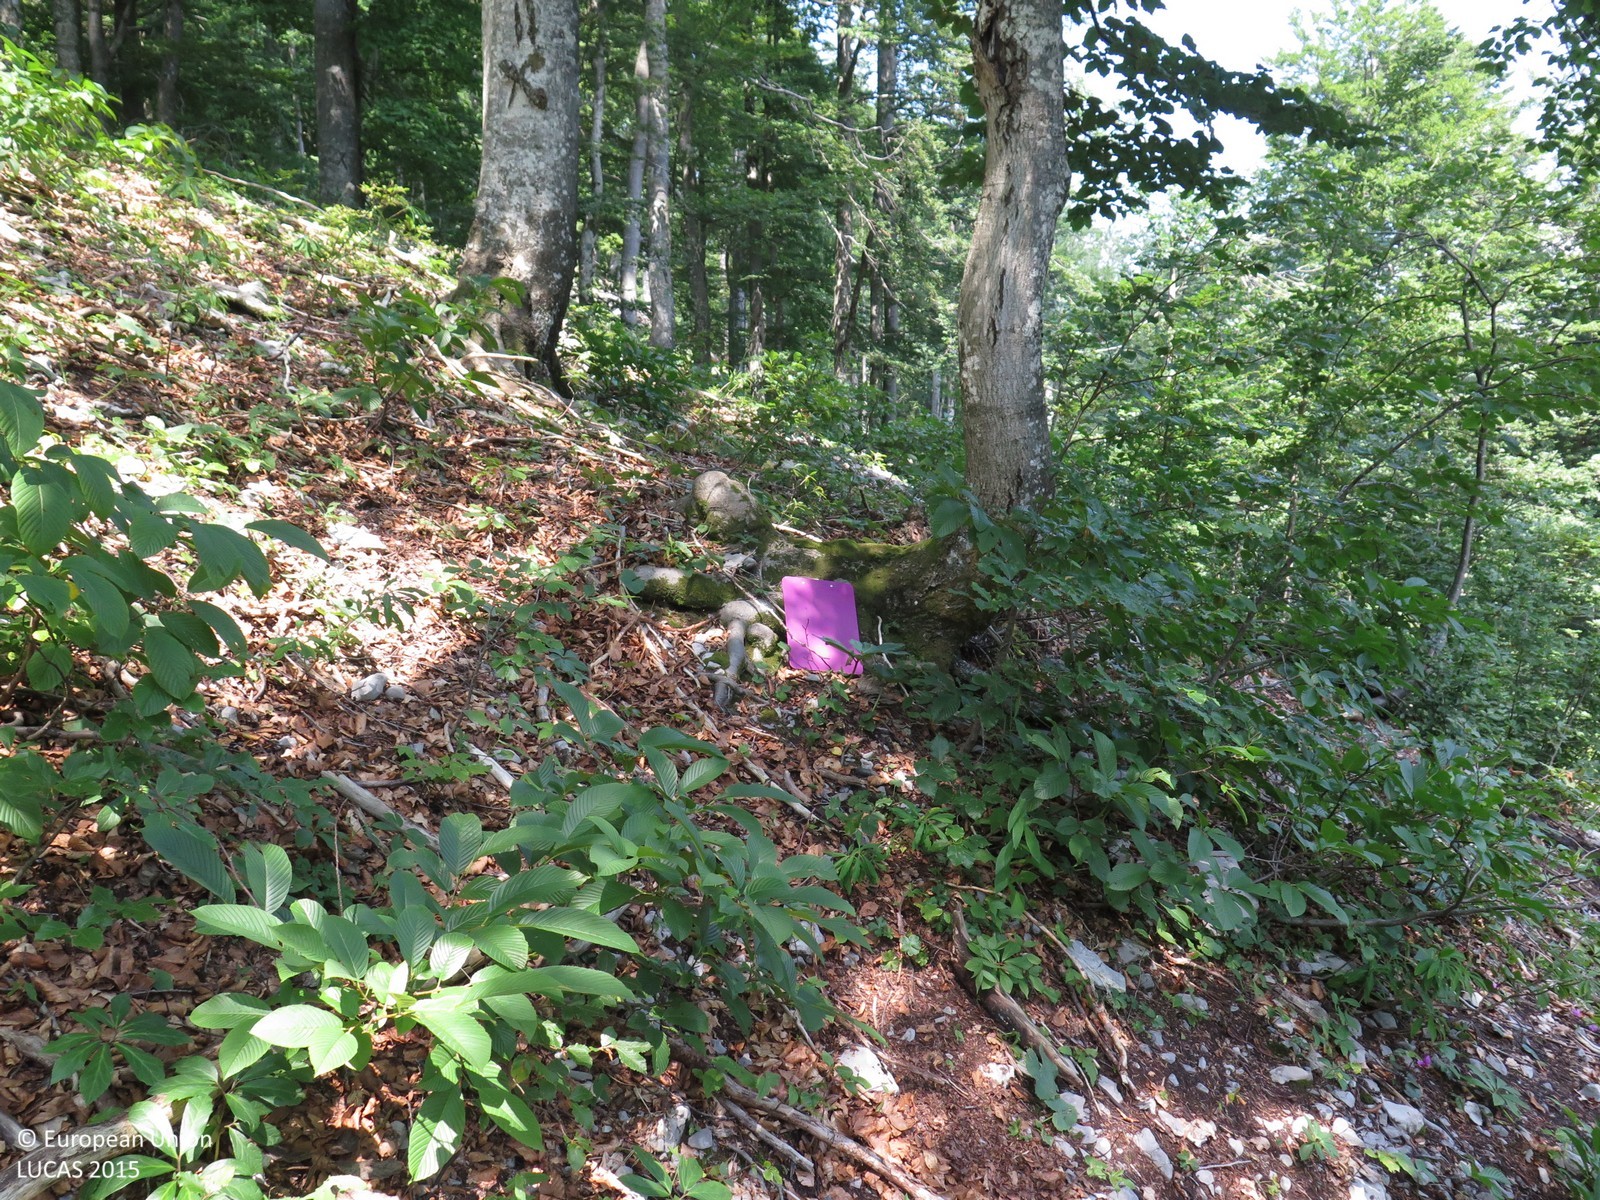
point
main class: Woodland
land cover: Other mixed woodland
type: mountainous beech forest
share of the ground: > 75 %
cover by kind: broadleaved forest trees 65 %, coniferous forest trees 25 %, shrubs 5 %, herbaceous plants 5 %
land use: Forestry
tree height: > 5 m
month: August
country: HR
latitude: 45.5151
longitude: 14.5398
